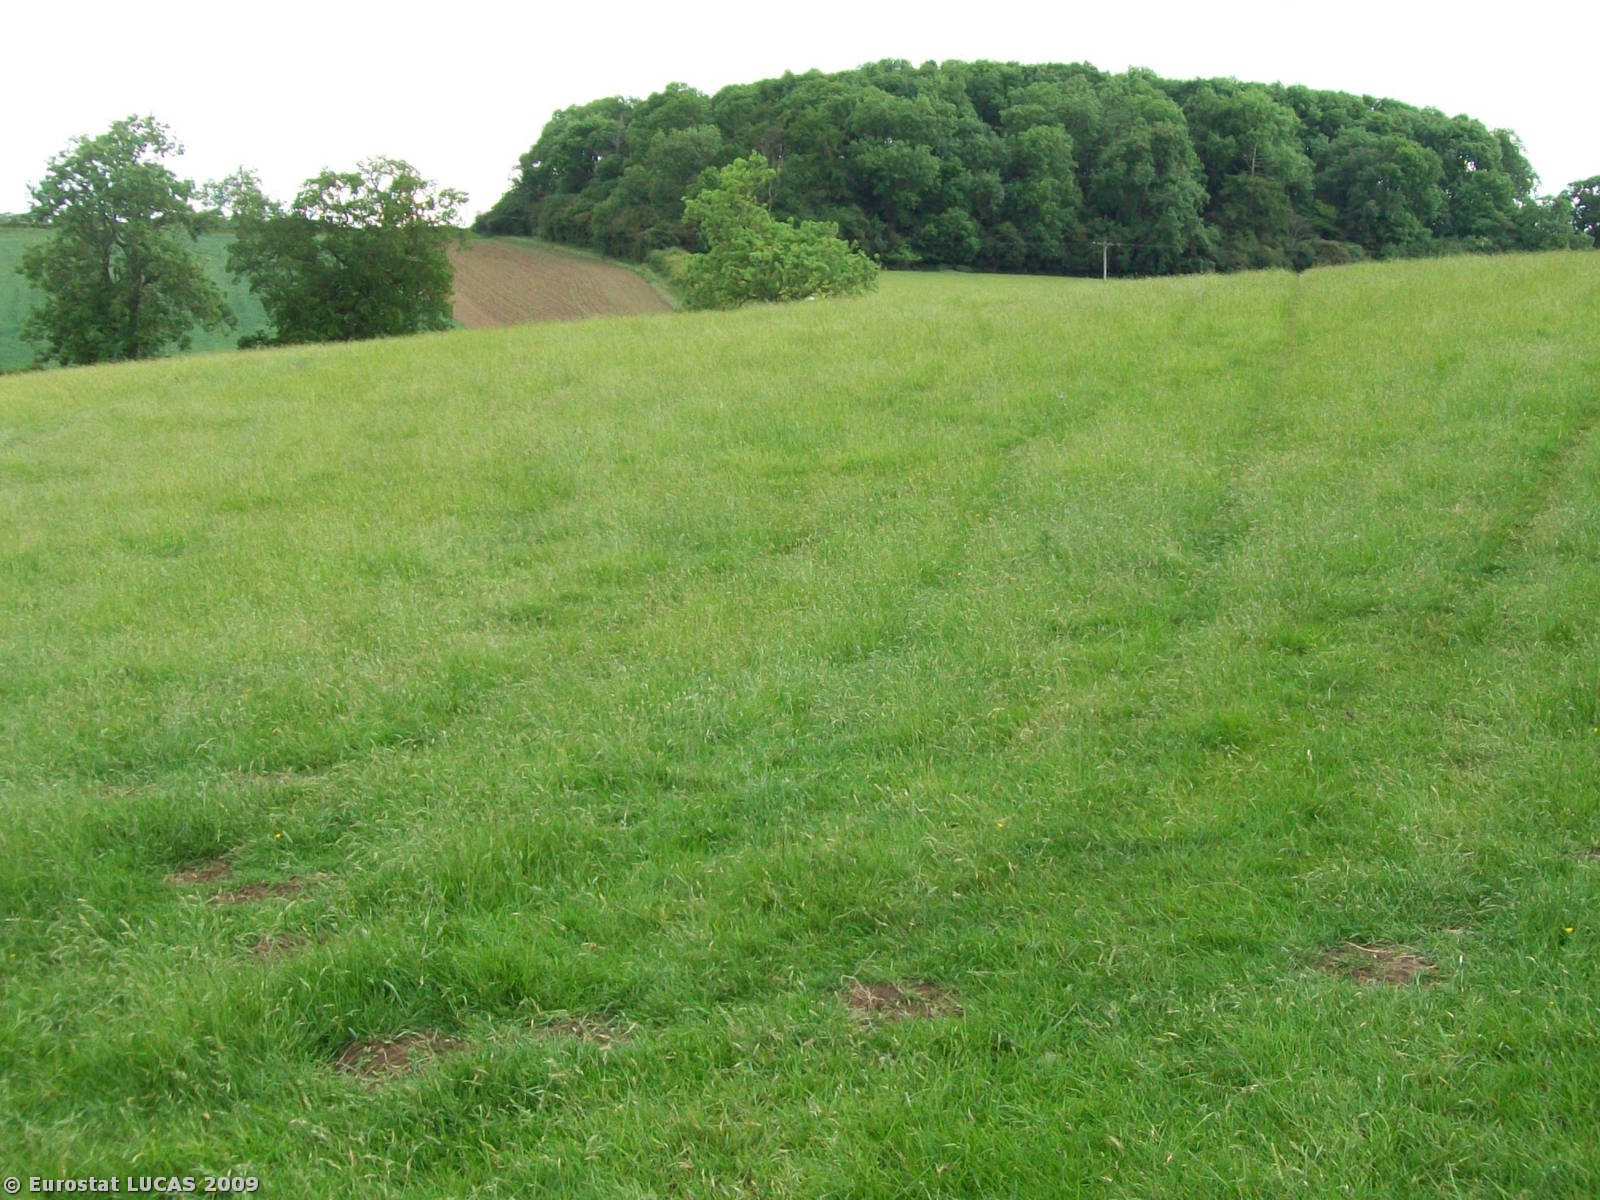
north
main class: Grassland
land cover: Grassland without tree/shrub cover
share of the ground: > 75 %
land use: Agriculture (excluding fallow land and kitchen gardens)
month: June
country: GB
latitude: 52.5551
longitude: -0.7938
